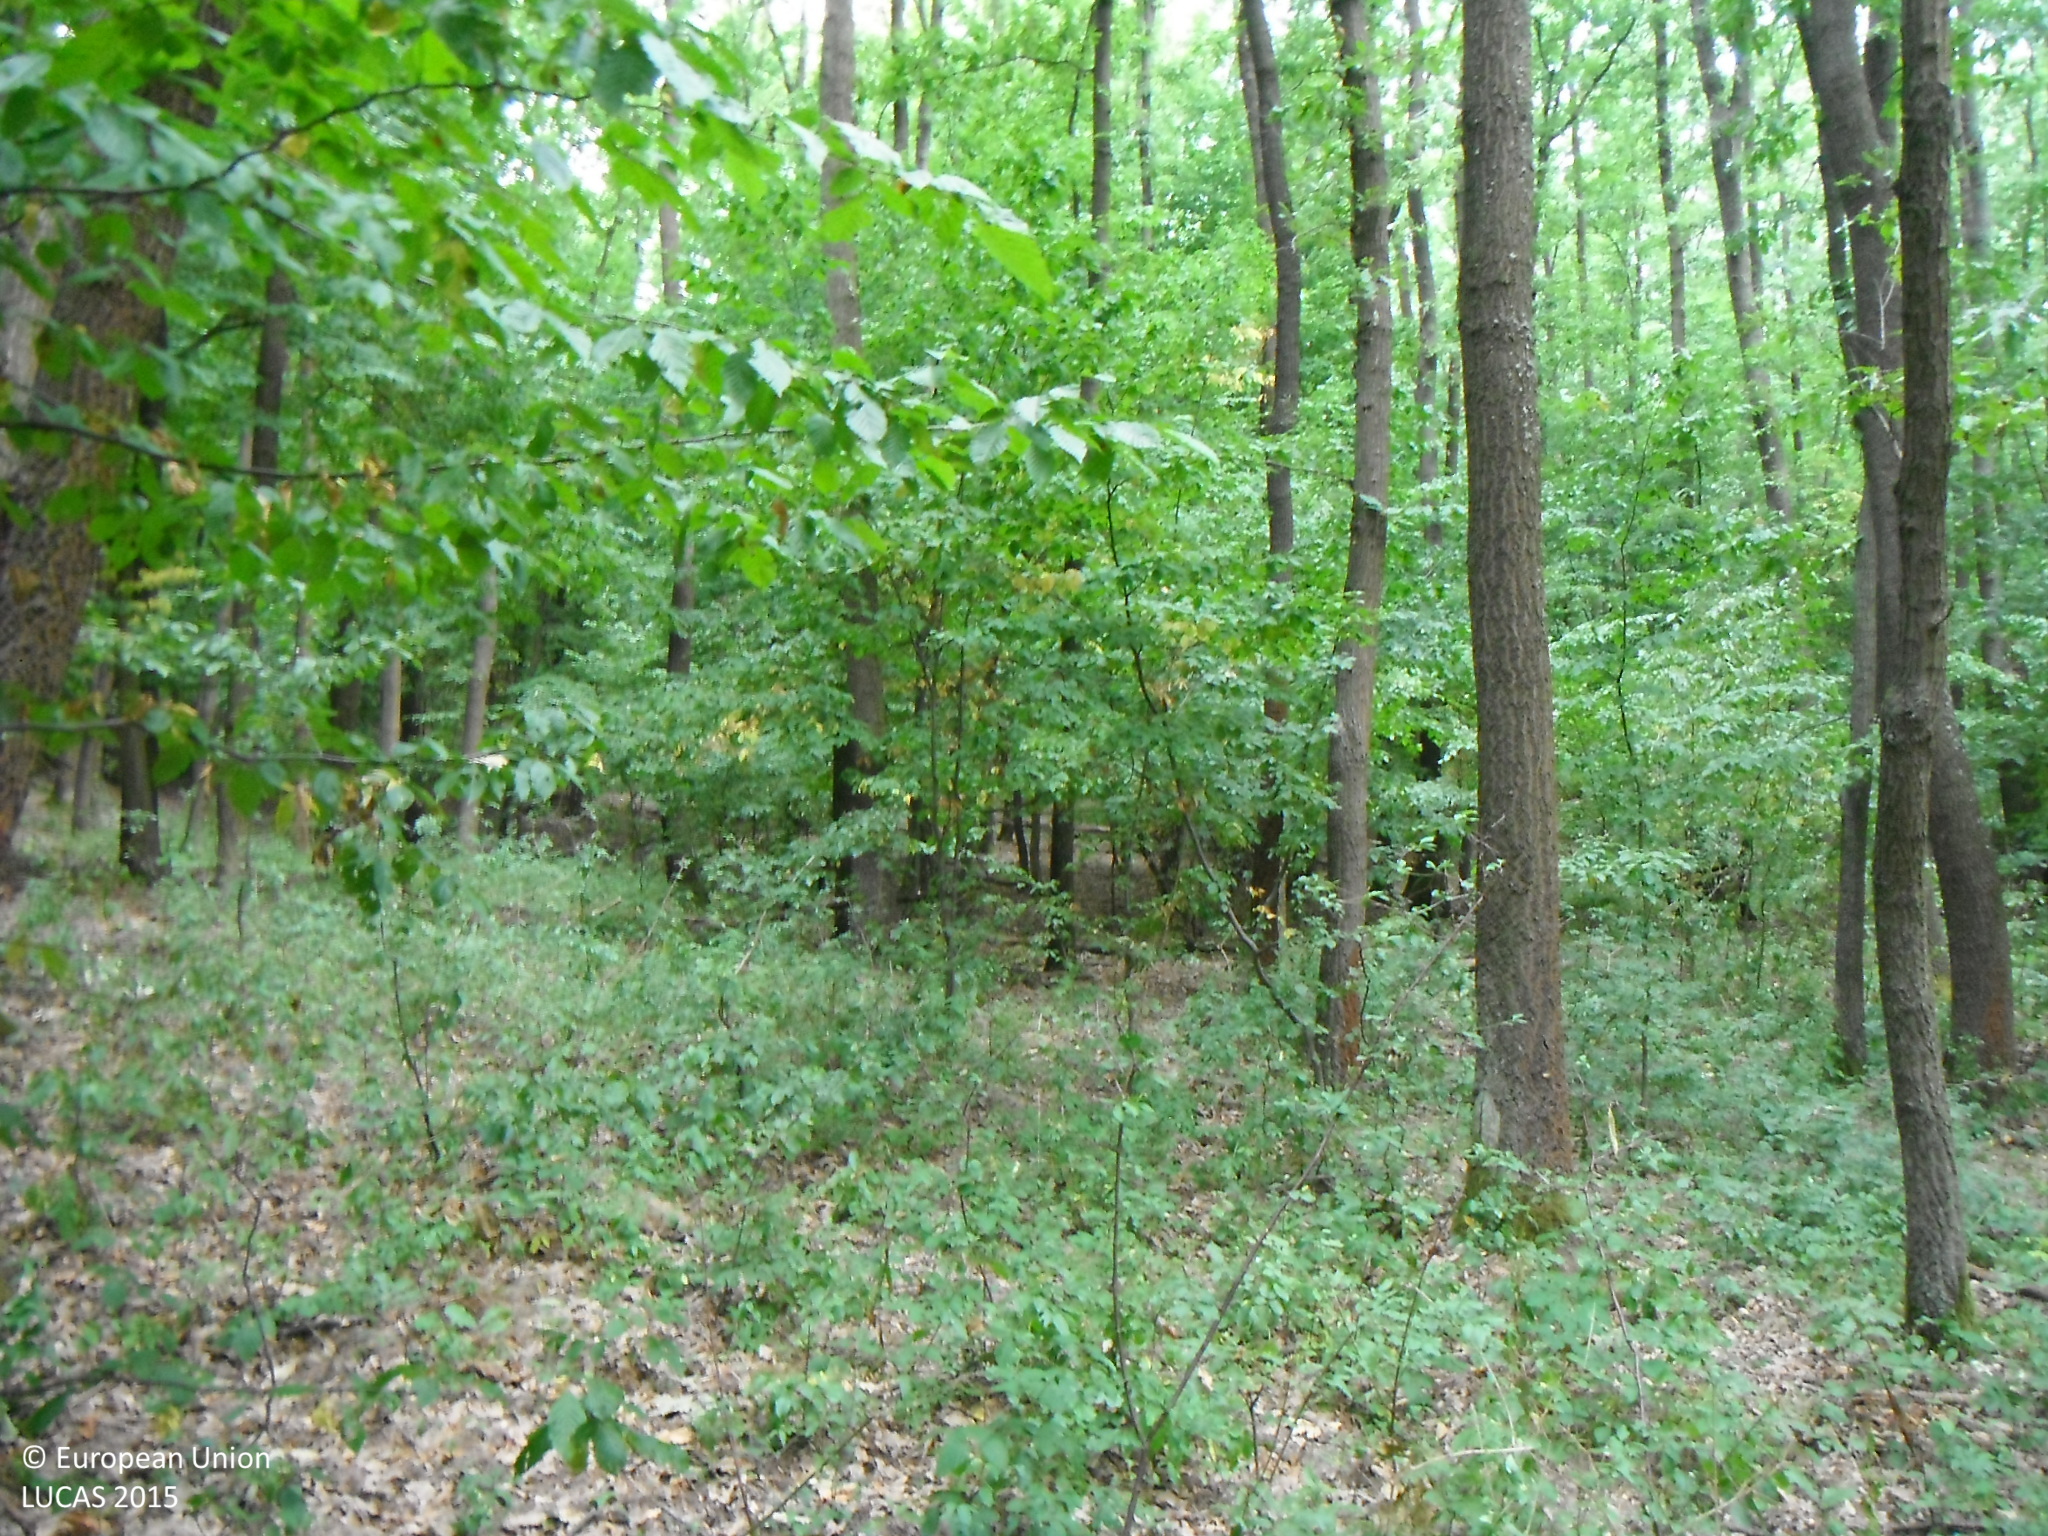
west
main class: Woodland
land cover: Broadleaved woodland
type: acidophilous oak and oak-birch forest
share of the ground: > 75 %
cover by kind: broadleaved forest trees 95 %, shrubs 5 %
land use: Forestry
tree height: > 5 m
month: July
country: SK
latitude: 48.2269
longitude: 19.7320
